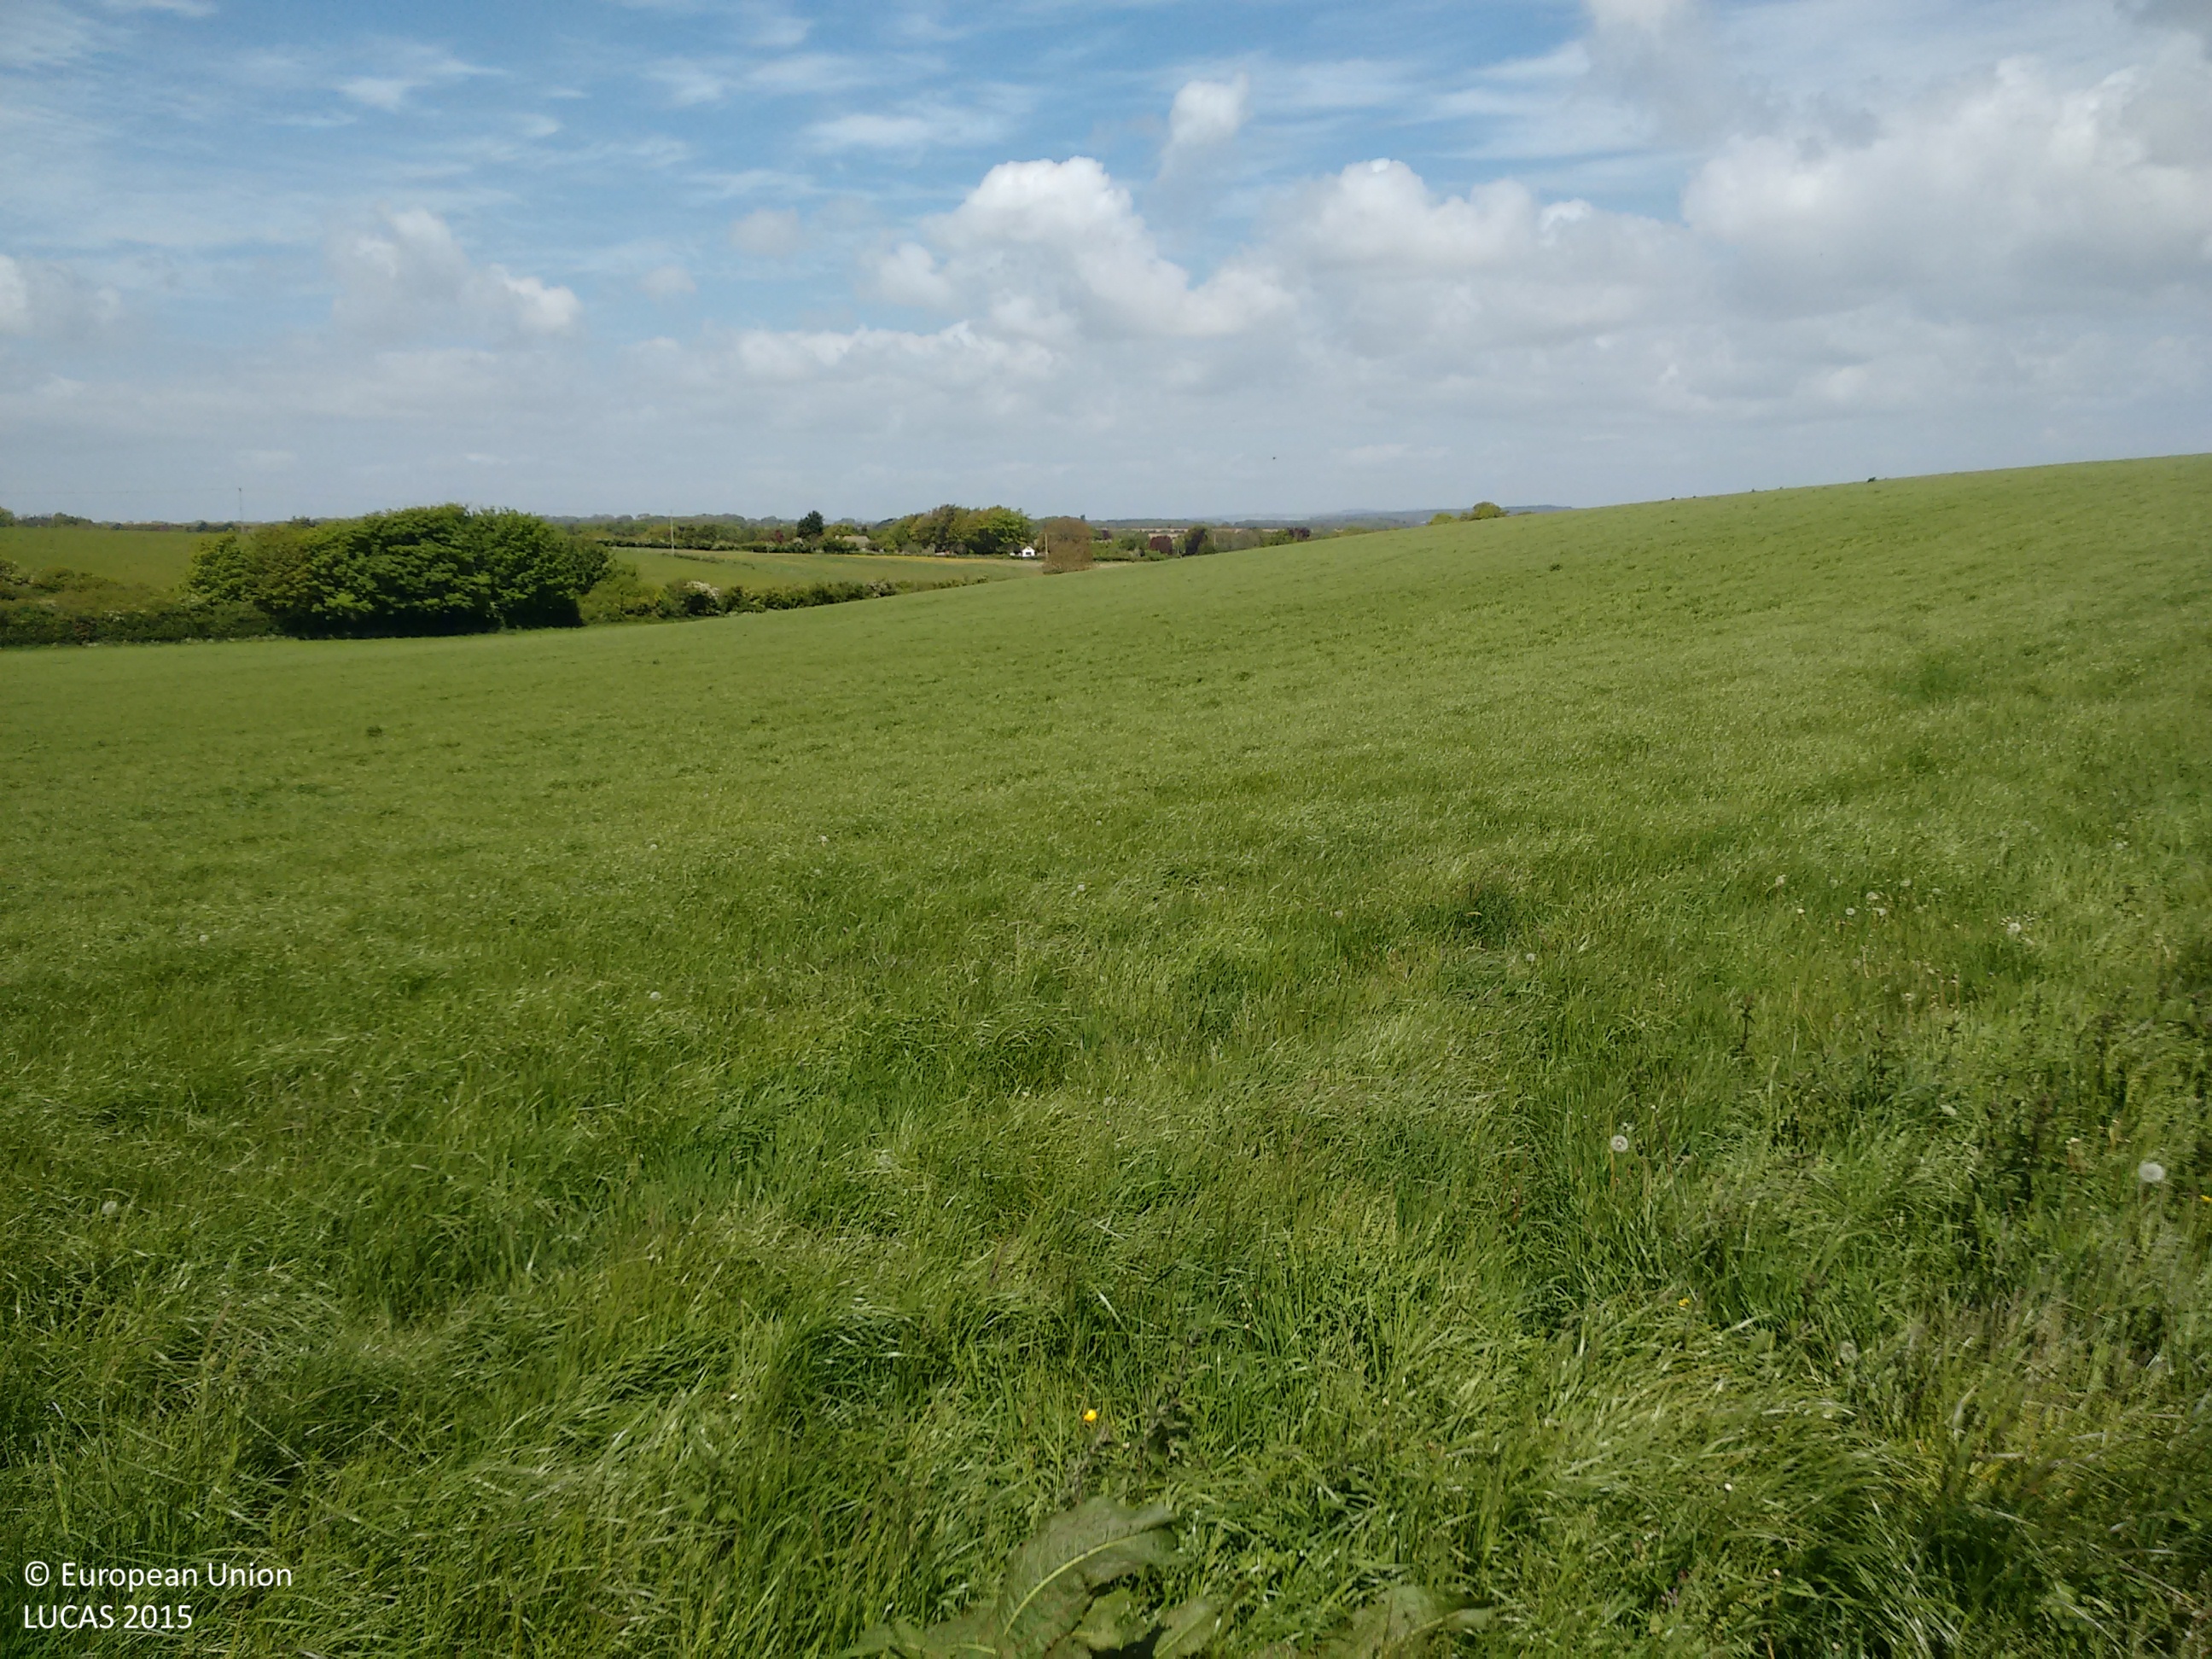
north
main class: Grassland
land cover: Grassland without tree/shrub cover
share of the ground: > 75 %
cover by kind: herbaceous plants 95 %, shrubs 5 %
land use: Agriculture (excluding fallow land and kitchen gardens)
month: May
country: GB
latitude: 50.6701
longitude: -2.3882
